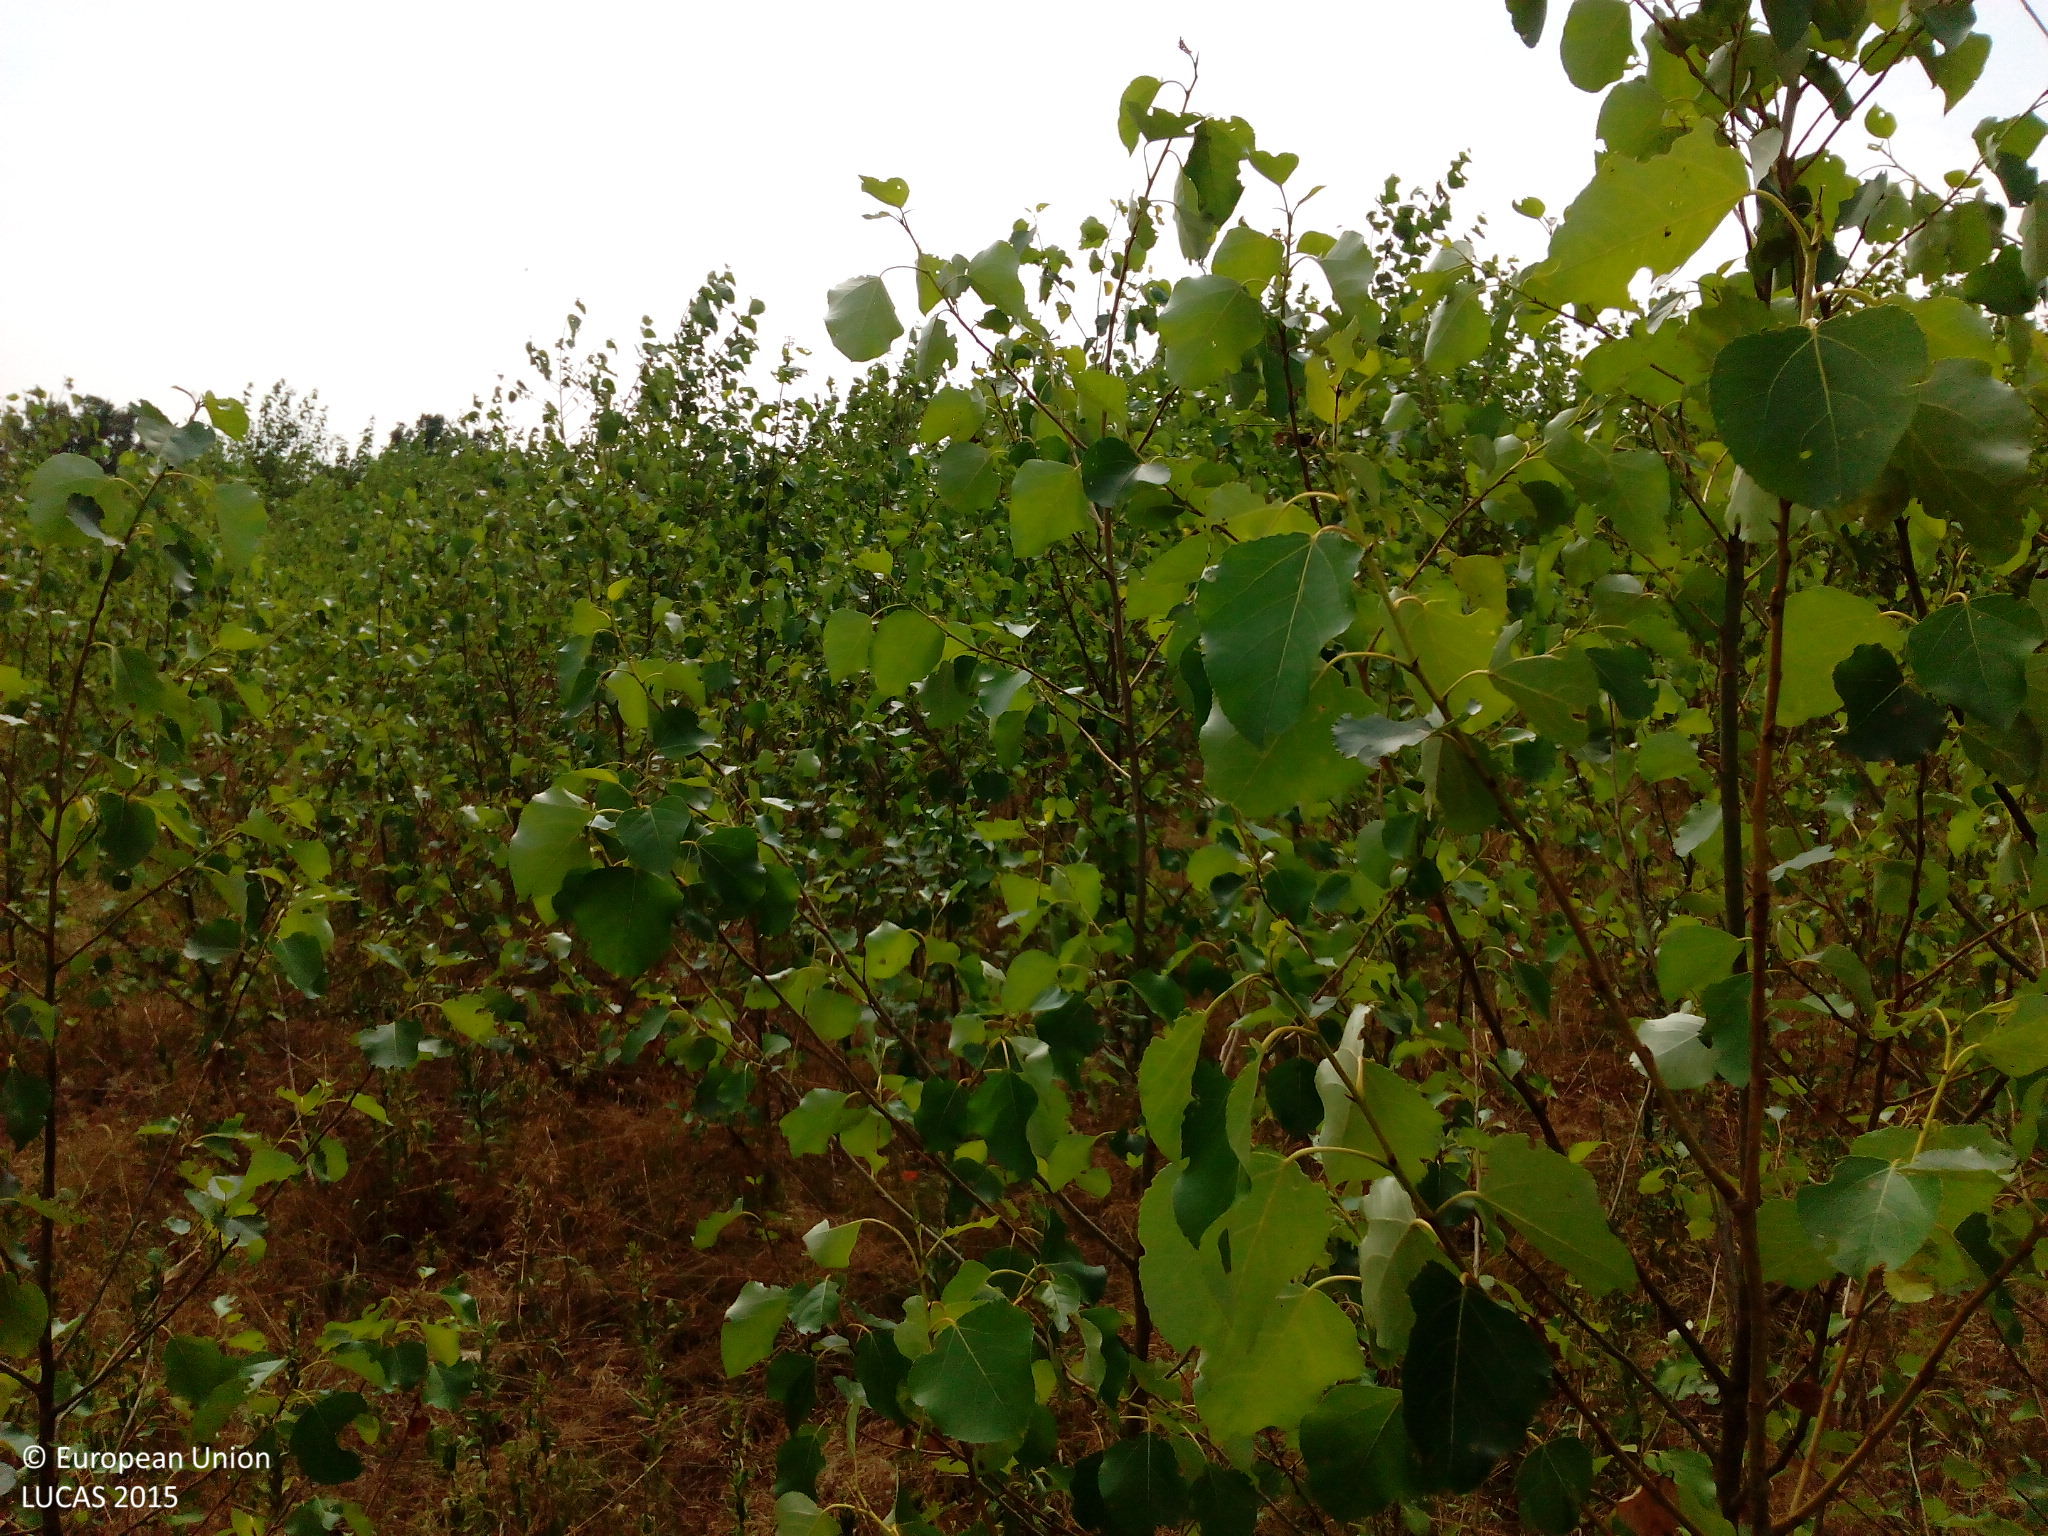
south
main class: Woodland
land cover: Broadleaved woodland
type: mesophytic deciduous forest
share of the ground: 25 - 50 %
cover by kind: broadleaved forest trees 50 %, herbaceous plants 50 %
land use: Semi-natural and natural areas not in use
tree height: < 5 m
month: August
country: DE
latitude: 52.6767
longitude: 13.1798
